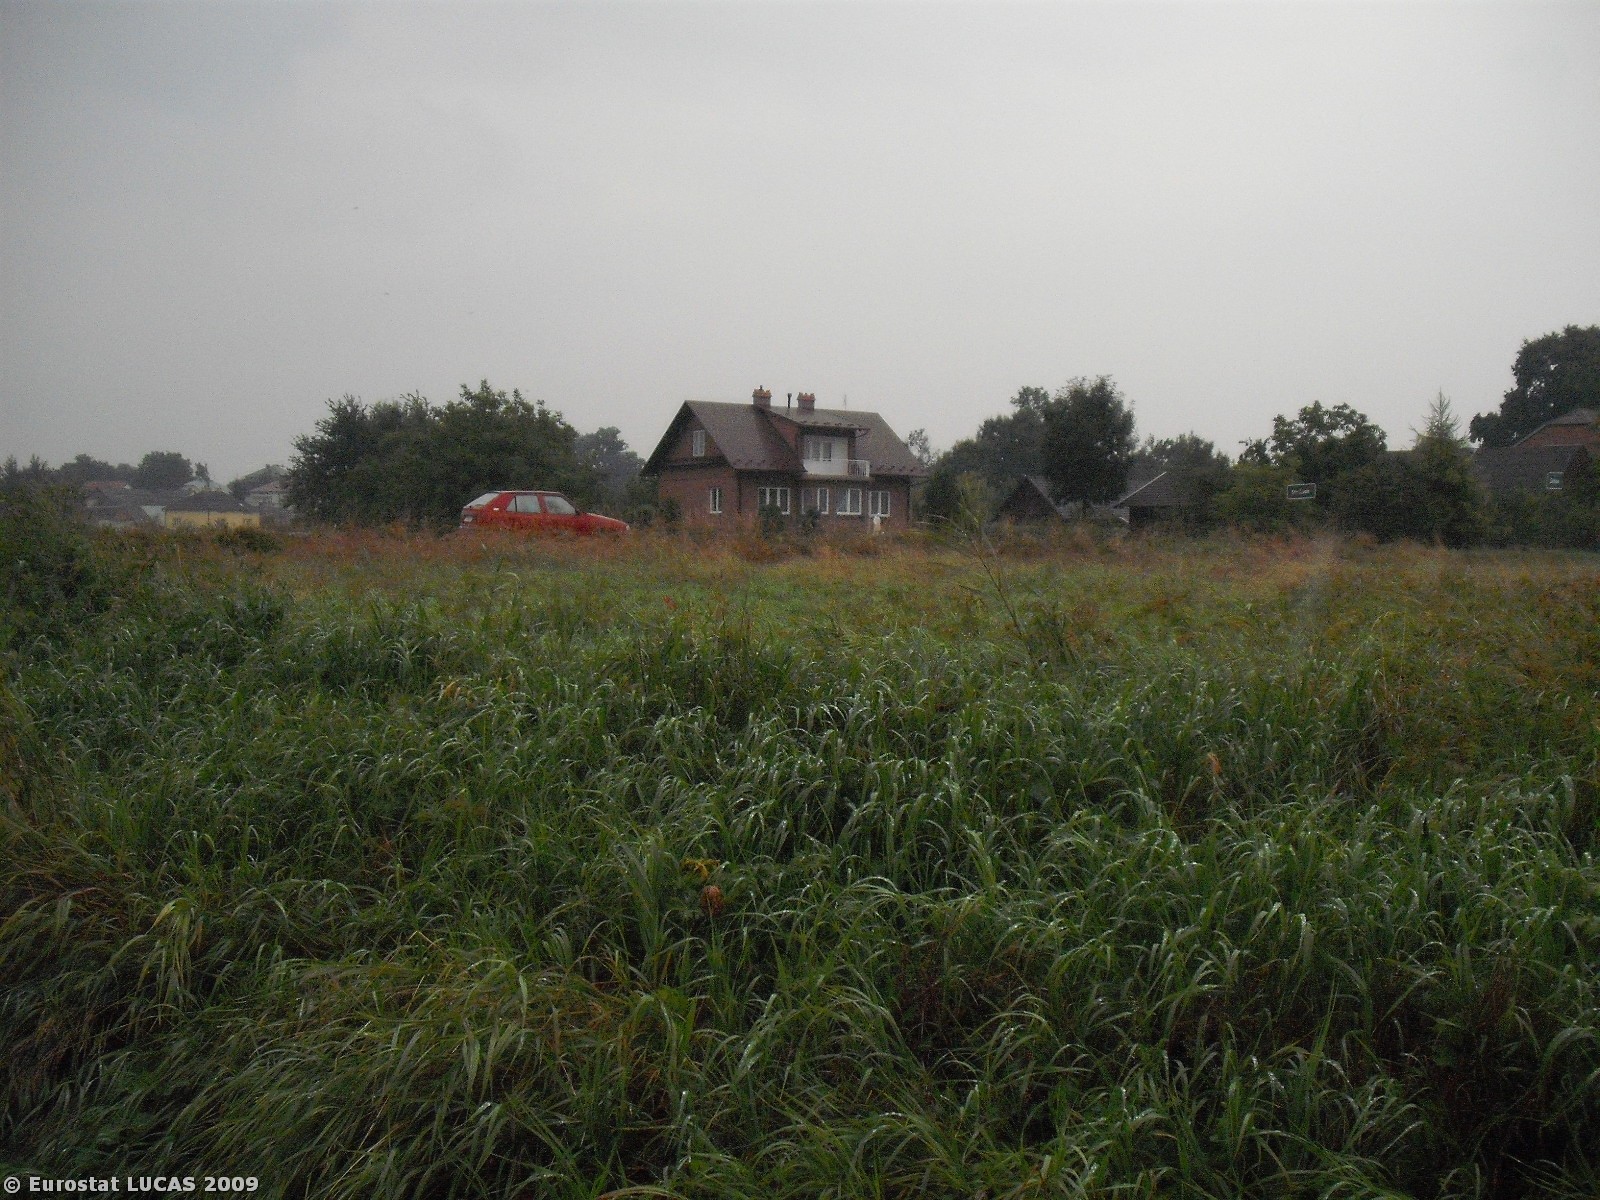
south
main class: Cropland
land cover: Maize
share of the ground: > 75 %
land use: Agriculture (excluding fallow land and kitchen gardens)
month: August
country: PL
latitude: 50.0445
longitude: 22.4506
